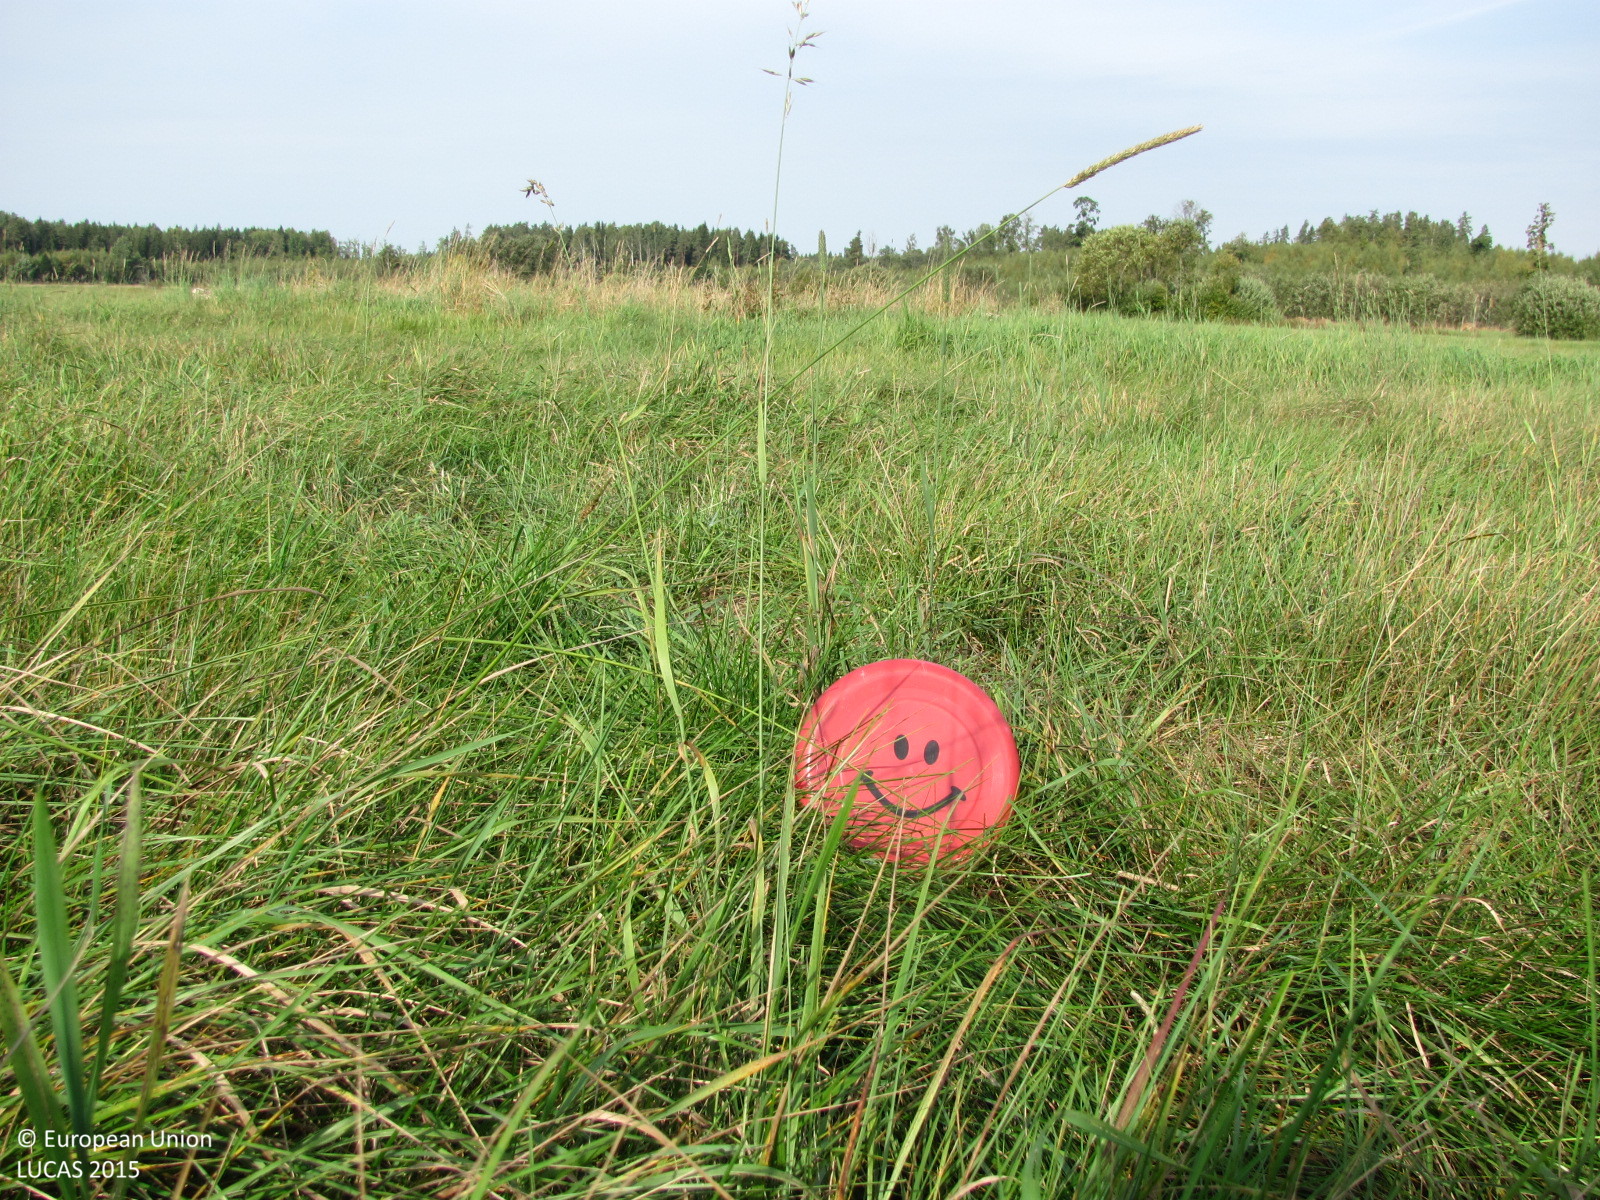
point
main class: Grassland
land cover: Grassland without tree/shrub cover
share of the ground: > 75 %
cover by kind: herbaceous plants 100 %
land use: Agriculture (excluding fallow land and kitchen gardens)
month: September
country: LV
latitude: 57.2228
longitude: 24.6877
